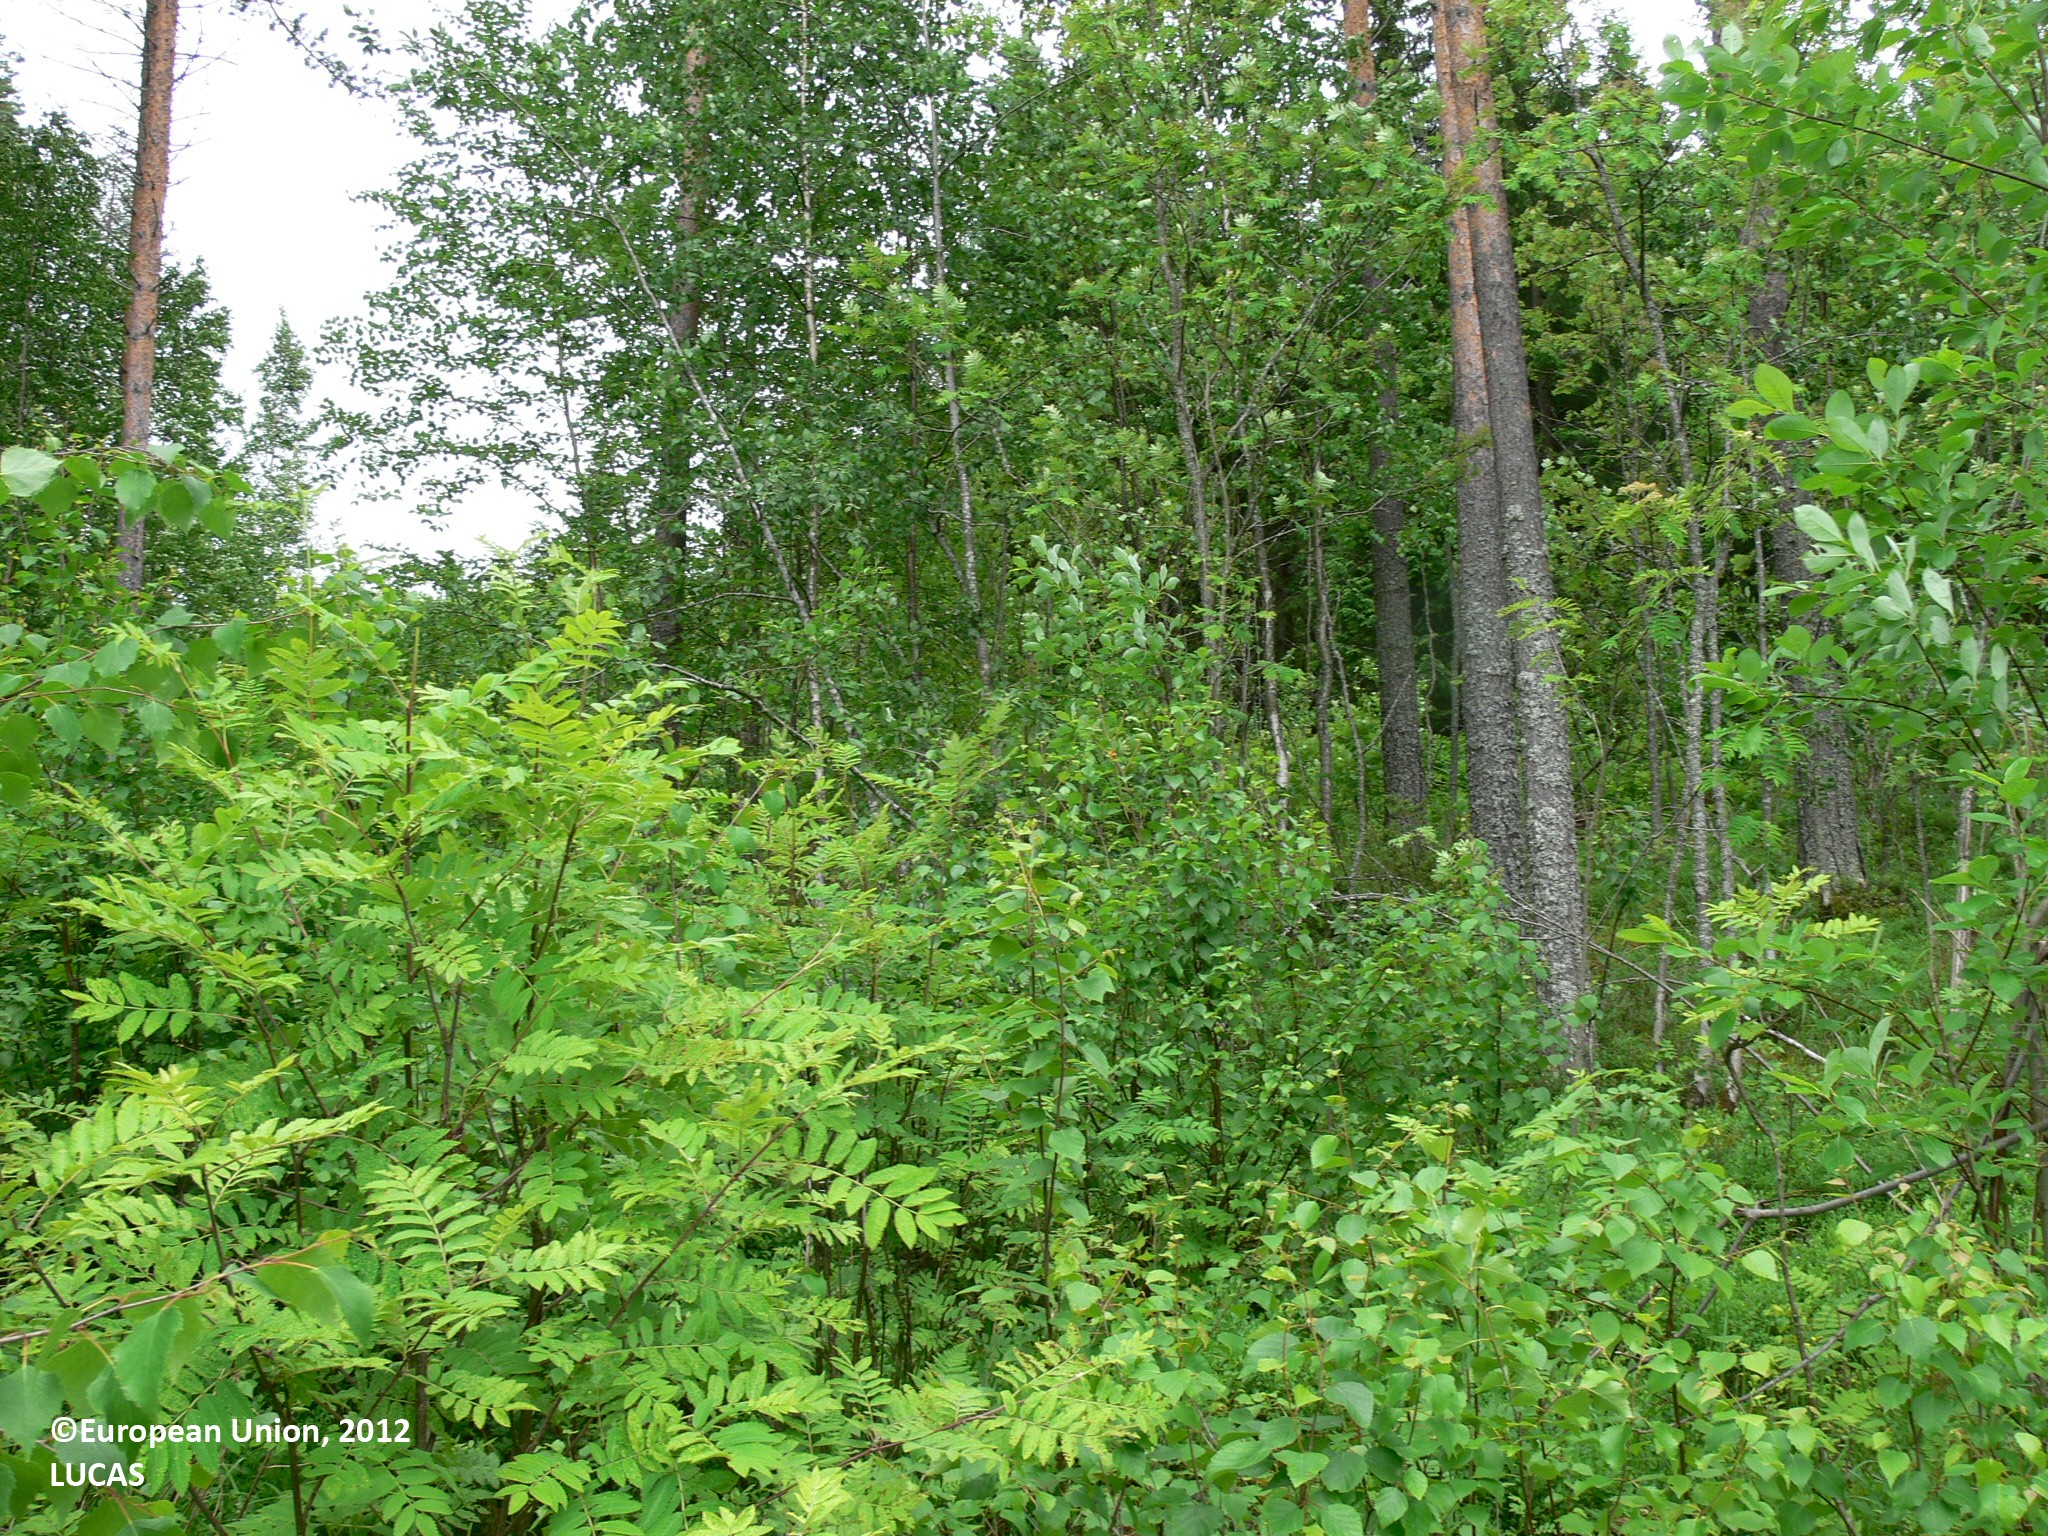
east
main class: Woodland
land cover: Broadleaved woodland
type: boreal forest
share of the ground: > 75 %
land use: Forestry
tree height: < 5 m
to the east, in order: Broadleaved woodland; Spruce dominated coniferous woodland; Pine dominated coniferous woodland; Tracks; Pine dominated coniferous woodland; Tracks; Pine dominated coniferous woodland; Rocks and stones; Electric lines; Rocks and stones; Paved roads, cycling and walking lanes; Grassland with sparse tree/shrub cover; Pine dominated coniferous woodland; Tracks; Pine dominated coniferous woodland
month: June
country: FI
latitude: 62.7133
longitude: 29.5366
